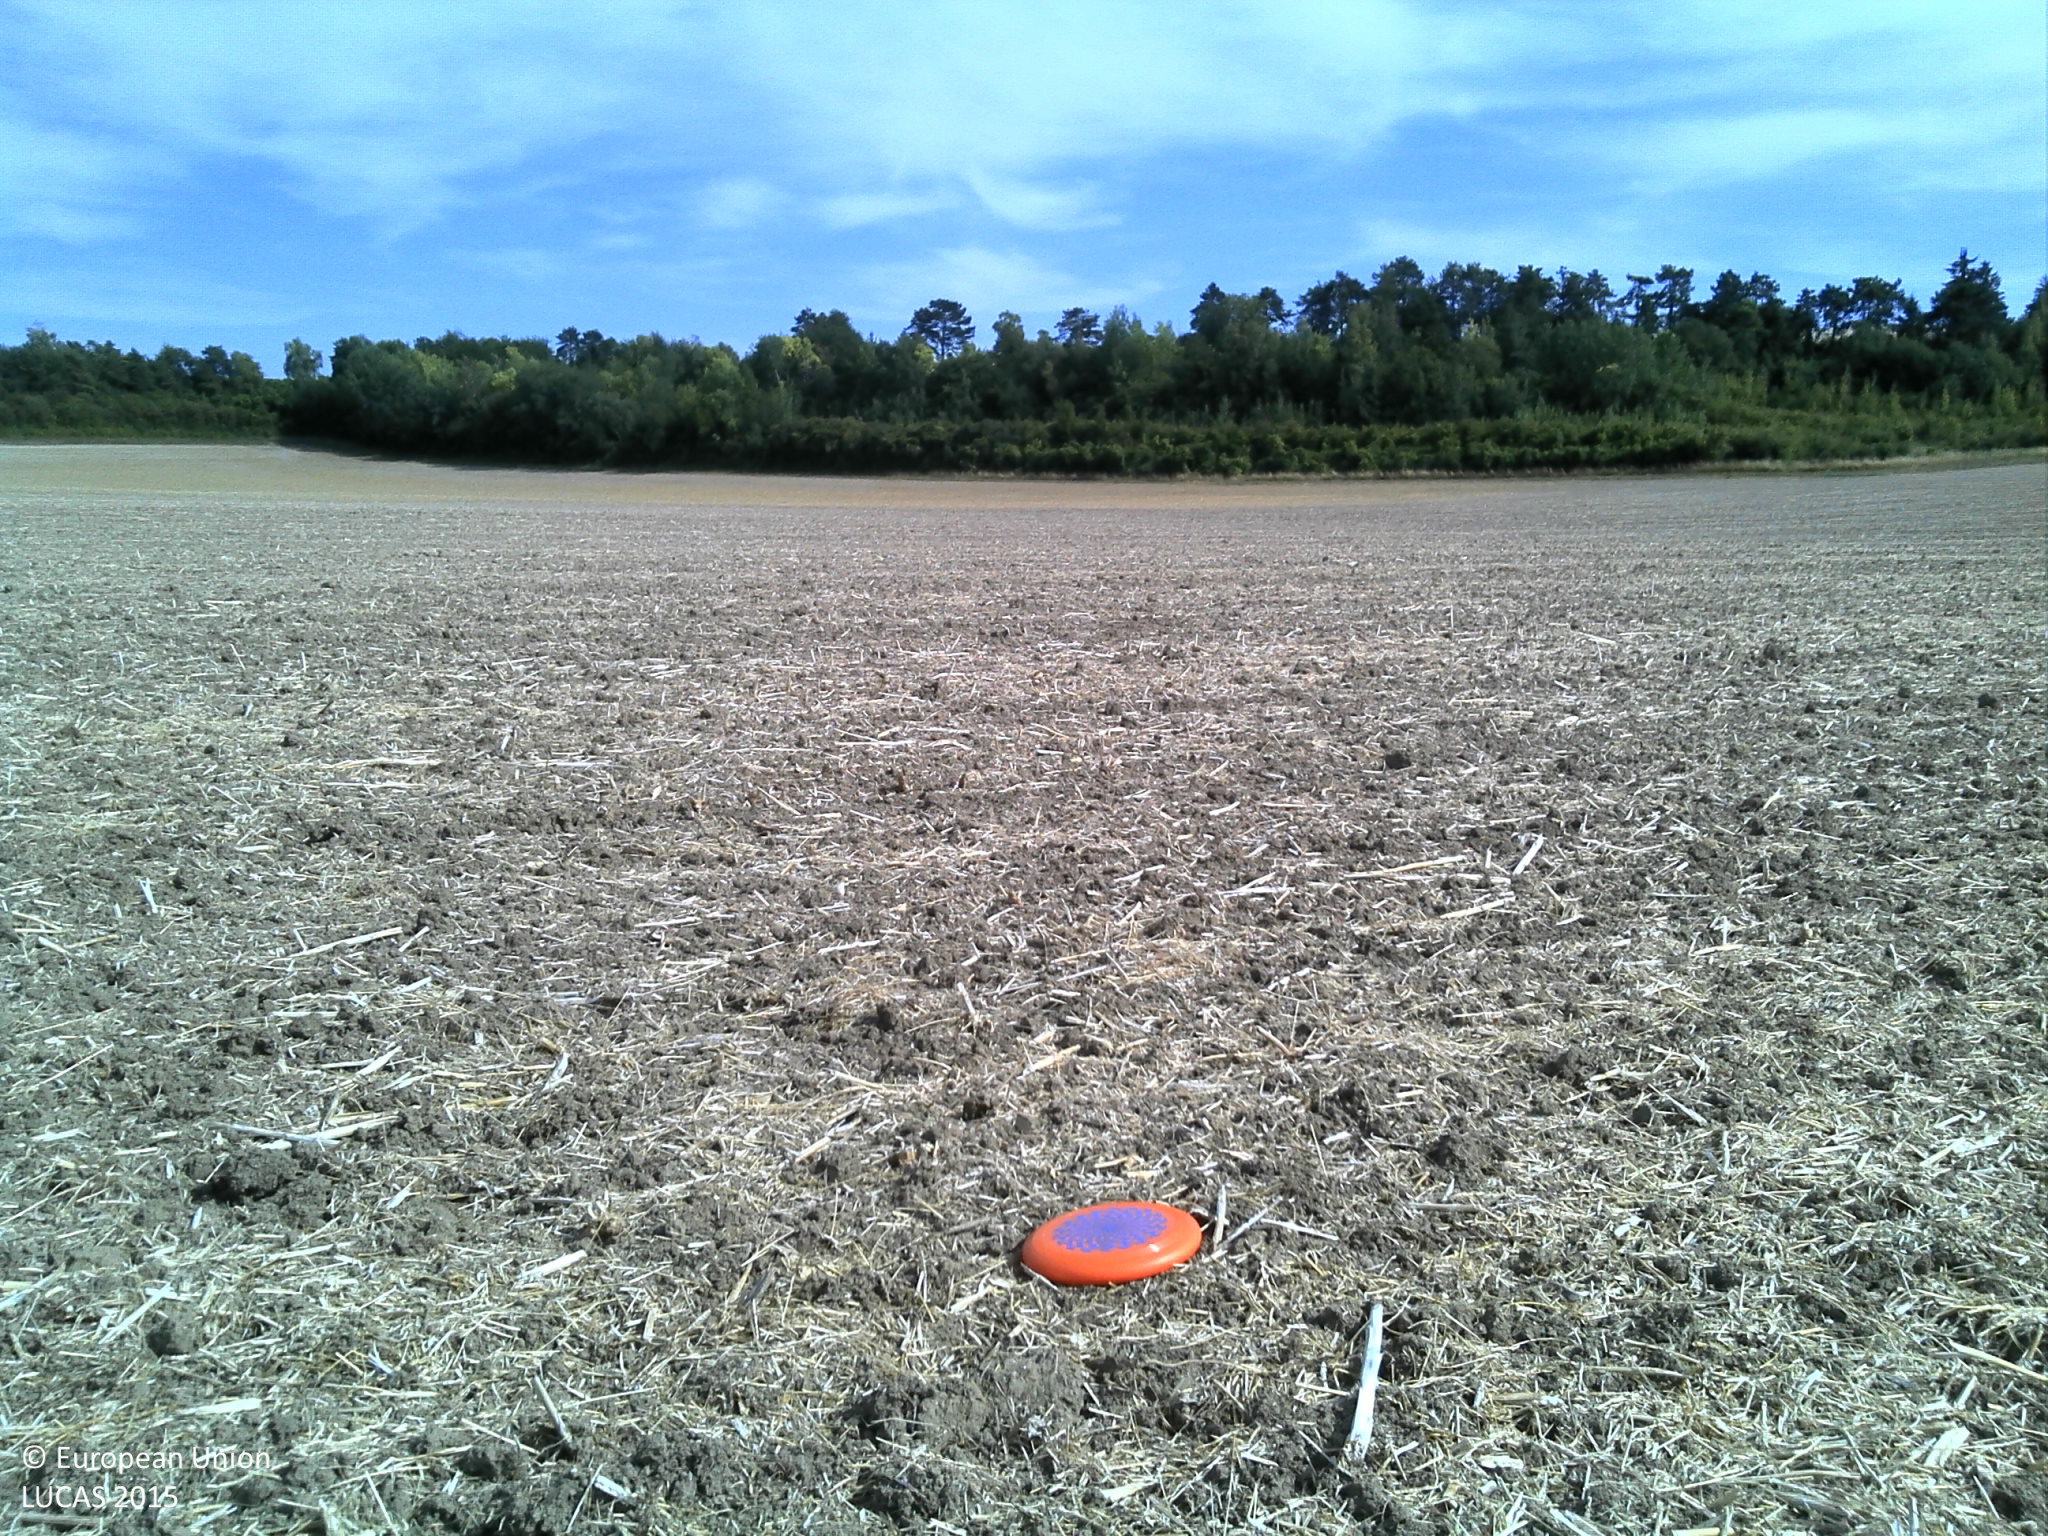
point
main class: Cropland
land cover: Rape and turnip rape
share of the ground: > 75 %
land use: Agriculture (excluding fallow land and kitchen gardens)
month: August
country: FR
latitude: 49.0031
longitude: 4.8167
